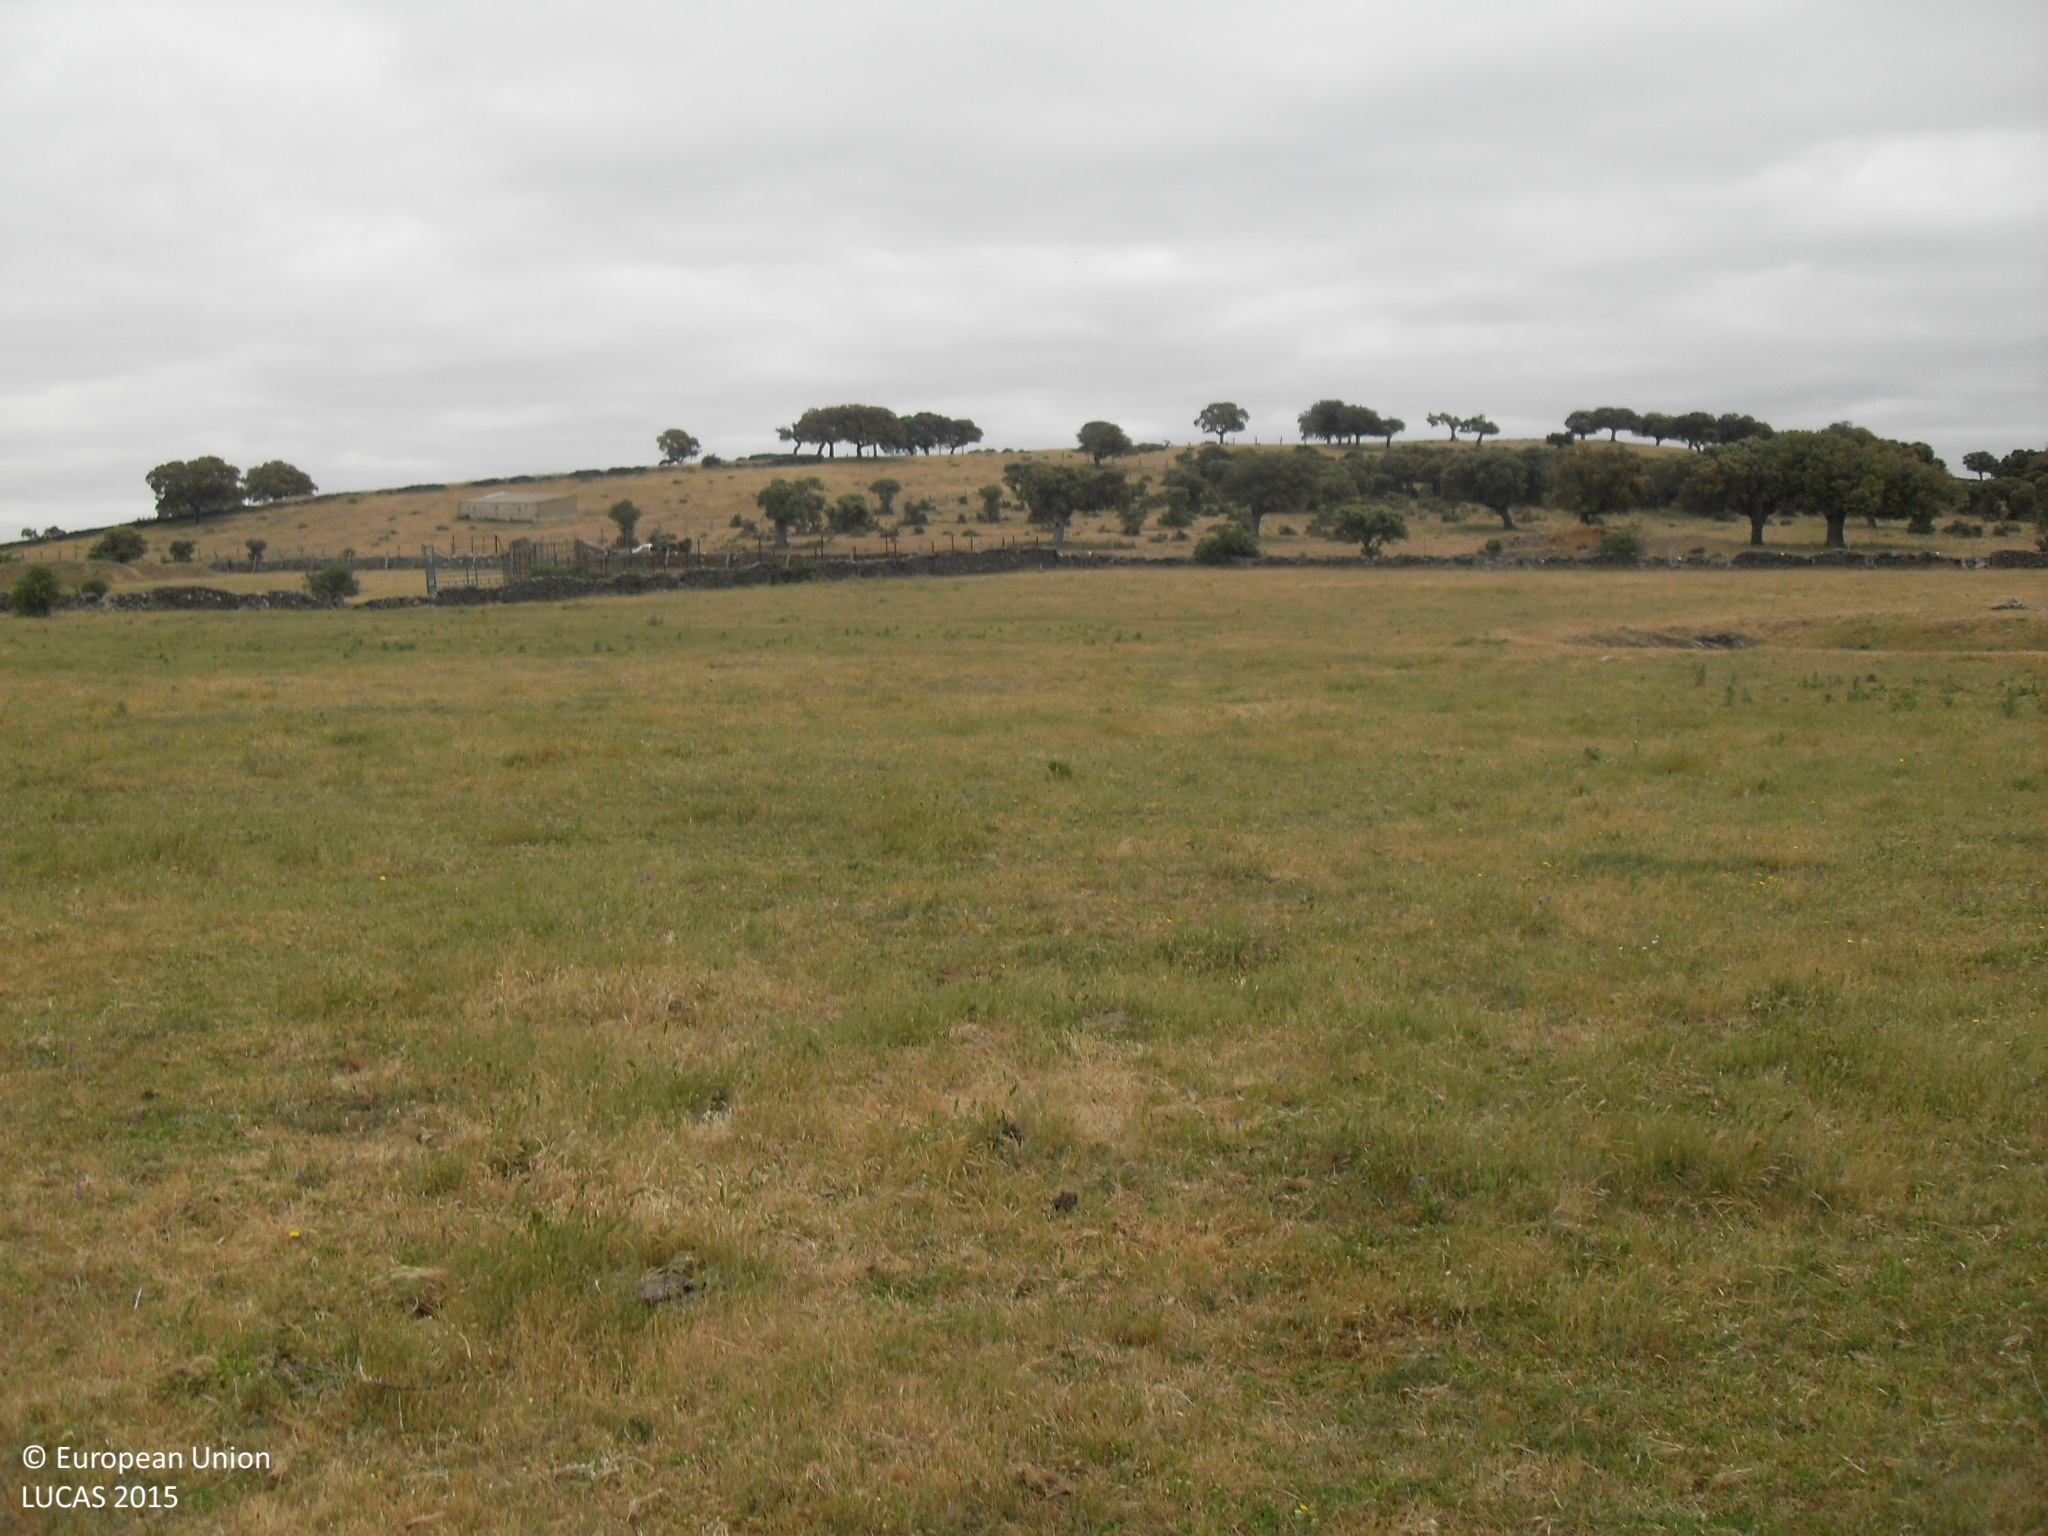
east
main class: Grassland
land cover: Grassland without tree/shrub cover
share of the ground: > 75 %
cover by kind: herbaceous plants 100 %
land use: Agriculture (excluding fallow land and kitchen gardens)
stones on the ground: 10 - 25 %
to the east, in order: Grassland without tree/shrub cover; Dry stone walls; Grass margins; Tracks; Grass margins; Fences; Grassland with sparse tree/shrub cover; Broadleaved woodland
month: May
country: ES
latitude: 40.6397
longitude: -5.6448
